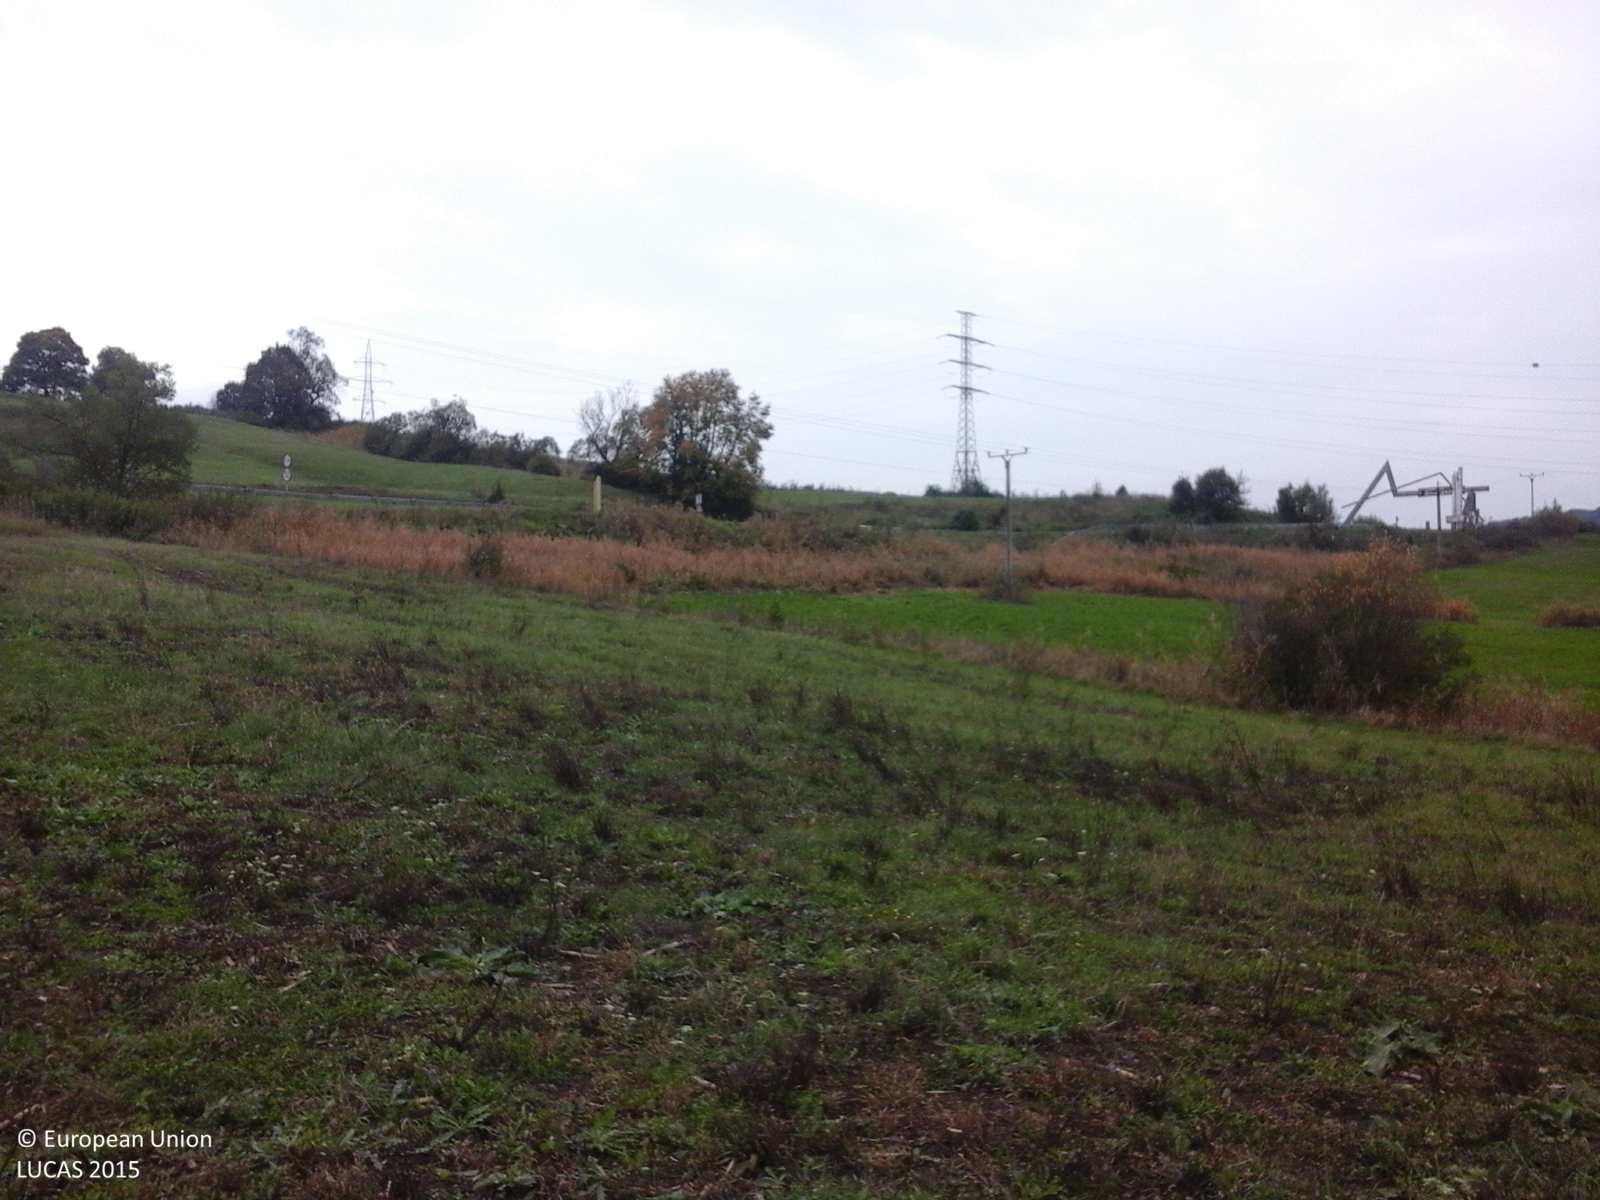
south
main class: Grassland
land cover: Grassland without tree/shrub cover
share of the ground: > 75 %
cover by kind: herbaceous plants 100 %
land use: Agriculture (excluding fallow land and kitchen gardens)
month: October
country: RO
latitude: 46.1433
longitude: 25.0219
